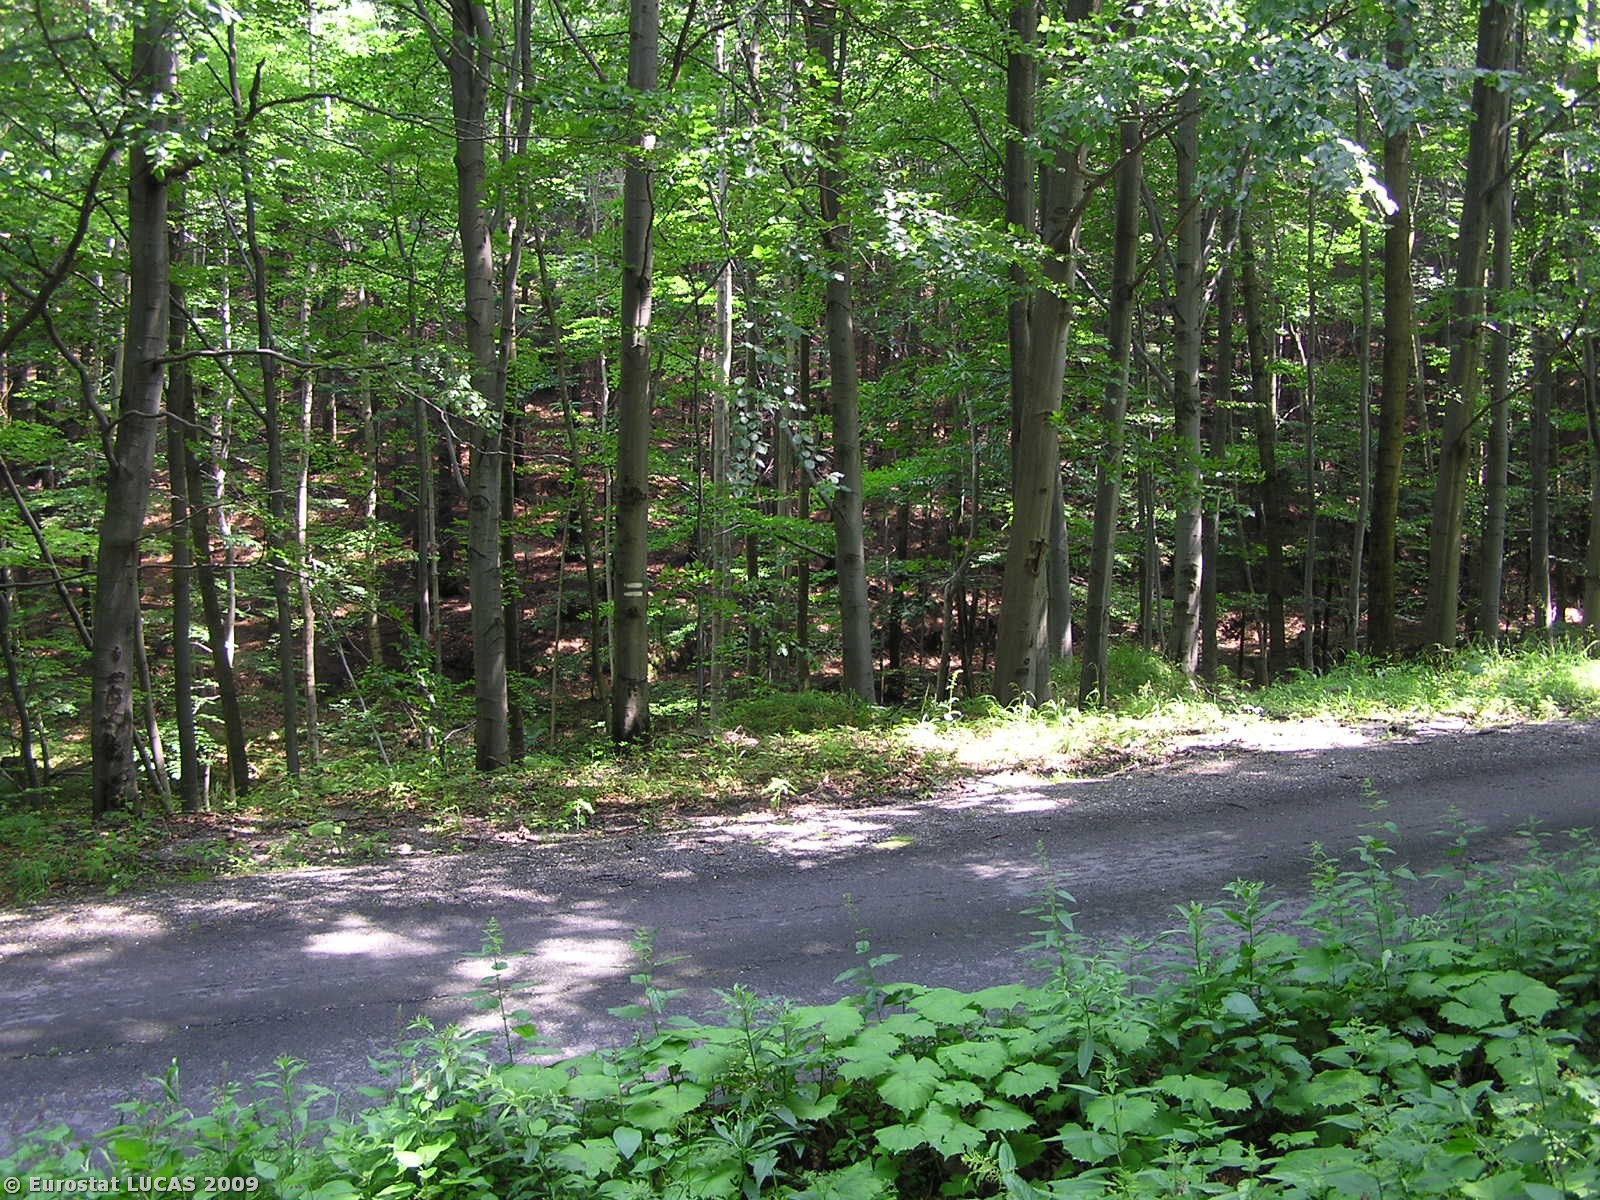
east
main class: Woodland
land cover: Broadleaved woodland
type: beech forest
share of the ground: > 75 %
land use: Forestry
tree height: > 5 m
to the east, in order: Broadleaved woodland; Ditches and canals; Paved roads, cycling and walking lanes; Broadleaved woodland; Rivers and streams; Mixed woodland; Tracks; Coniferous woodland; Broadleaved woodland; Ditches and canals; Paved roads, cycling and walking lanes; Mixed woodland
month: July
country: CZ
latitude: 50.2415
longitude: 17.2604
